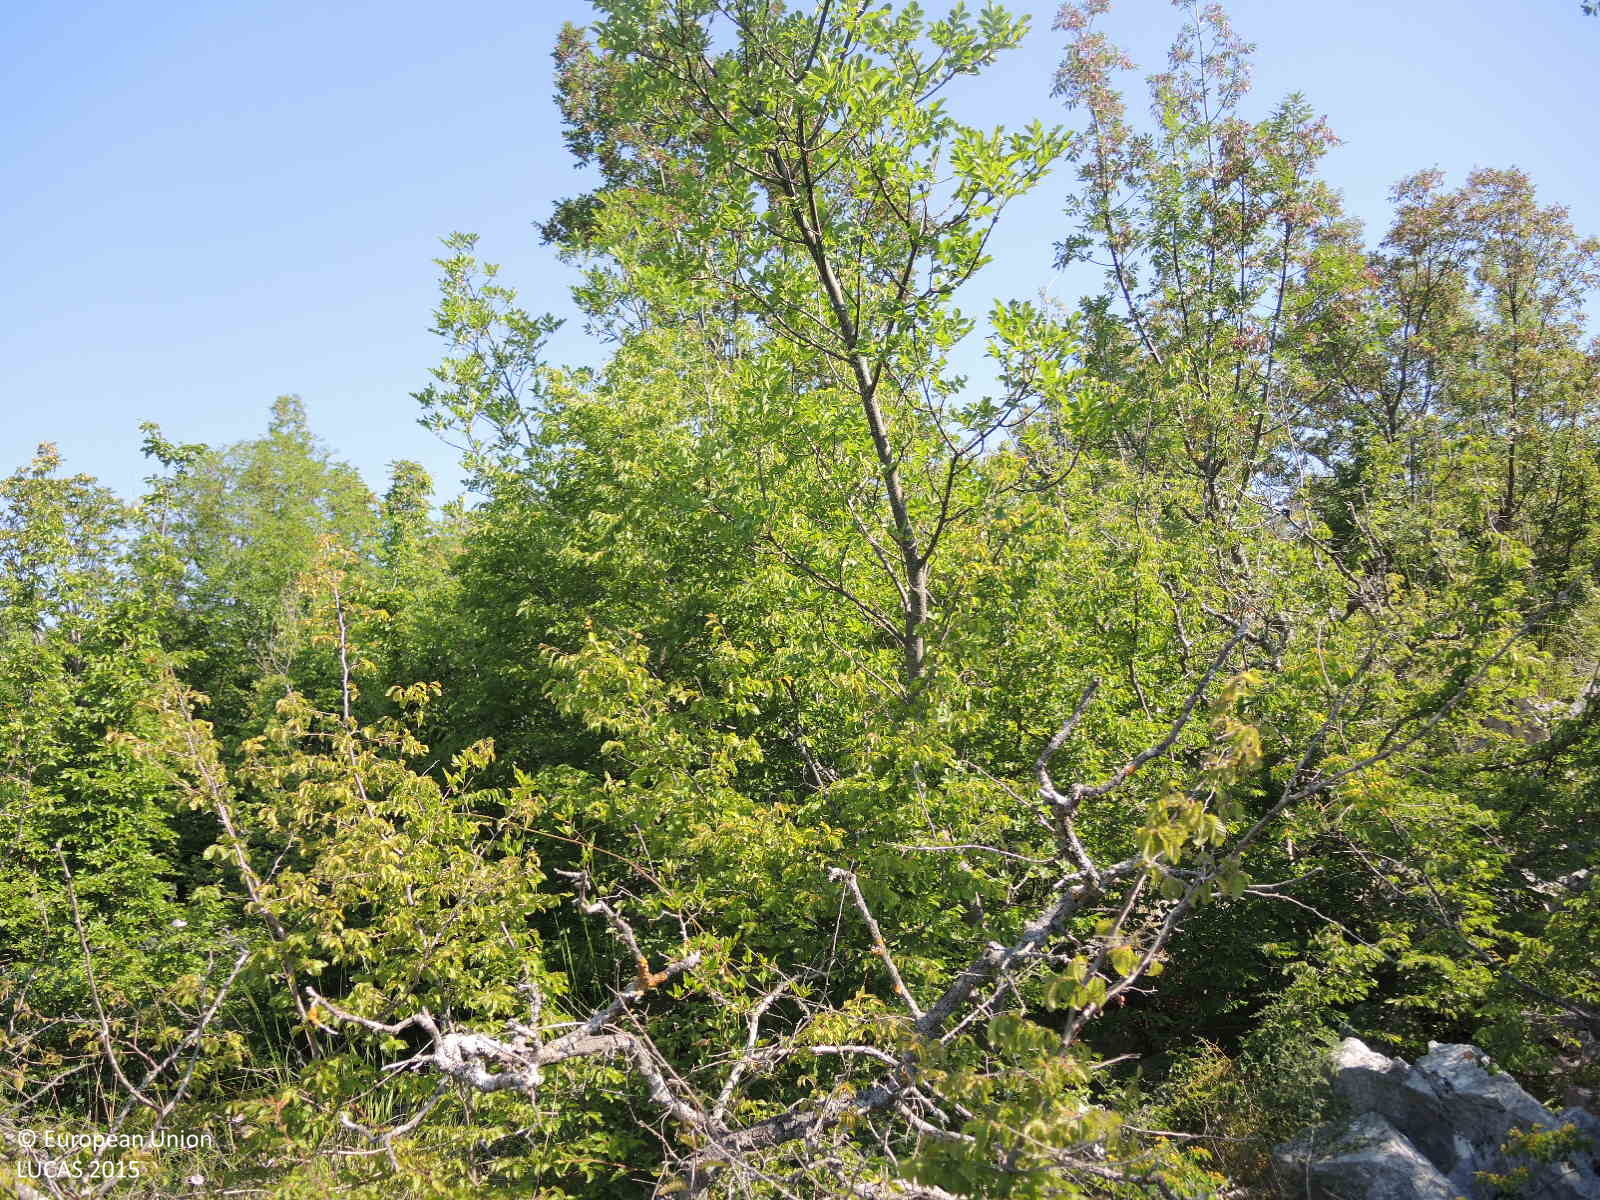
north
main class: Woodland
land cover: Broadleaved woodland
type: thermophilous deciduous forest
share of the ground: 50 - 75 %
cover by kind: broadleaved forest trees 50 %, consolidated bare surface 20 %, shrubs 15 %, unconsolidated bare surface 10 %, herbaceous plants 5 %
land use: Semi-natural and natural areas not in use
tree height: > 5 m
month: June
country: HR
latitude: 43.6539
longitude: 16.2775
